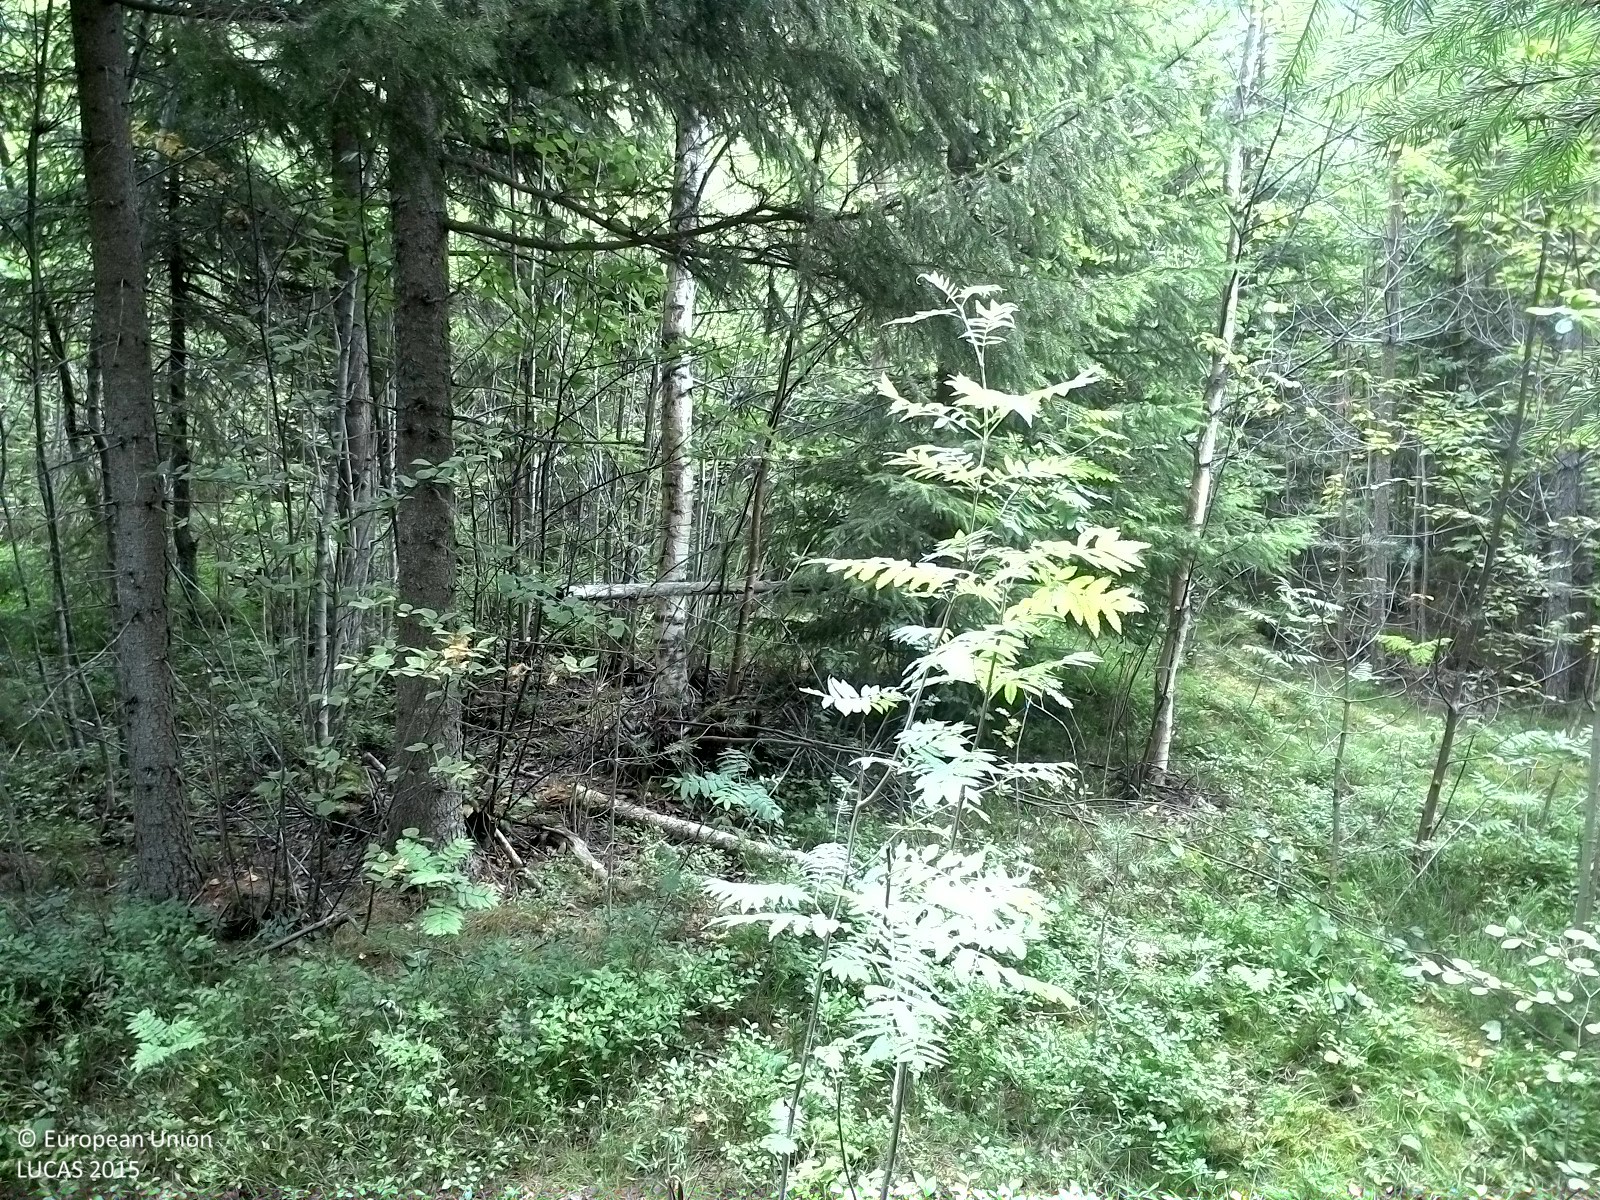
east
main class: Woodland
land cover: Spruce dominated mixed woodland
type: boreal forest
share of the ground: 50 - 75 %
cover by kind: coniferous forest trees 50 %, shrubs 30 %, broadleaved forest trees 20 %
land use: Forestry
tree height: > 5 m
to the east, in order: Spruce dominated mixed woodland; Other coniferous woodland; Pine dominated coniferous woodland; Other coniferous woodland
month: August
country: SE
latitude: 62.4898
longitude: 17.2959
